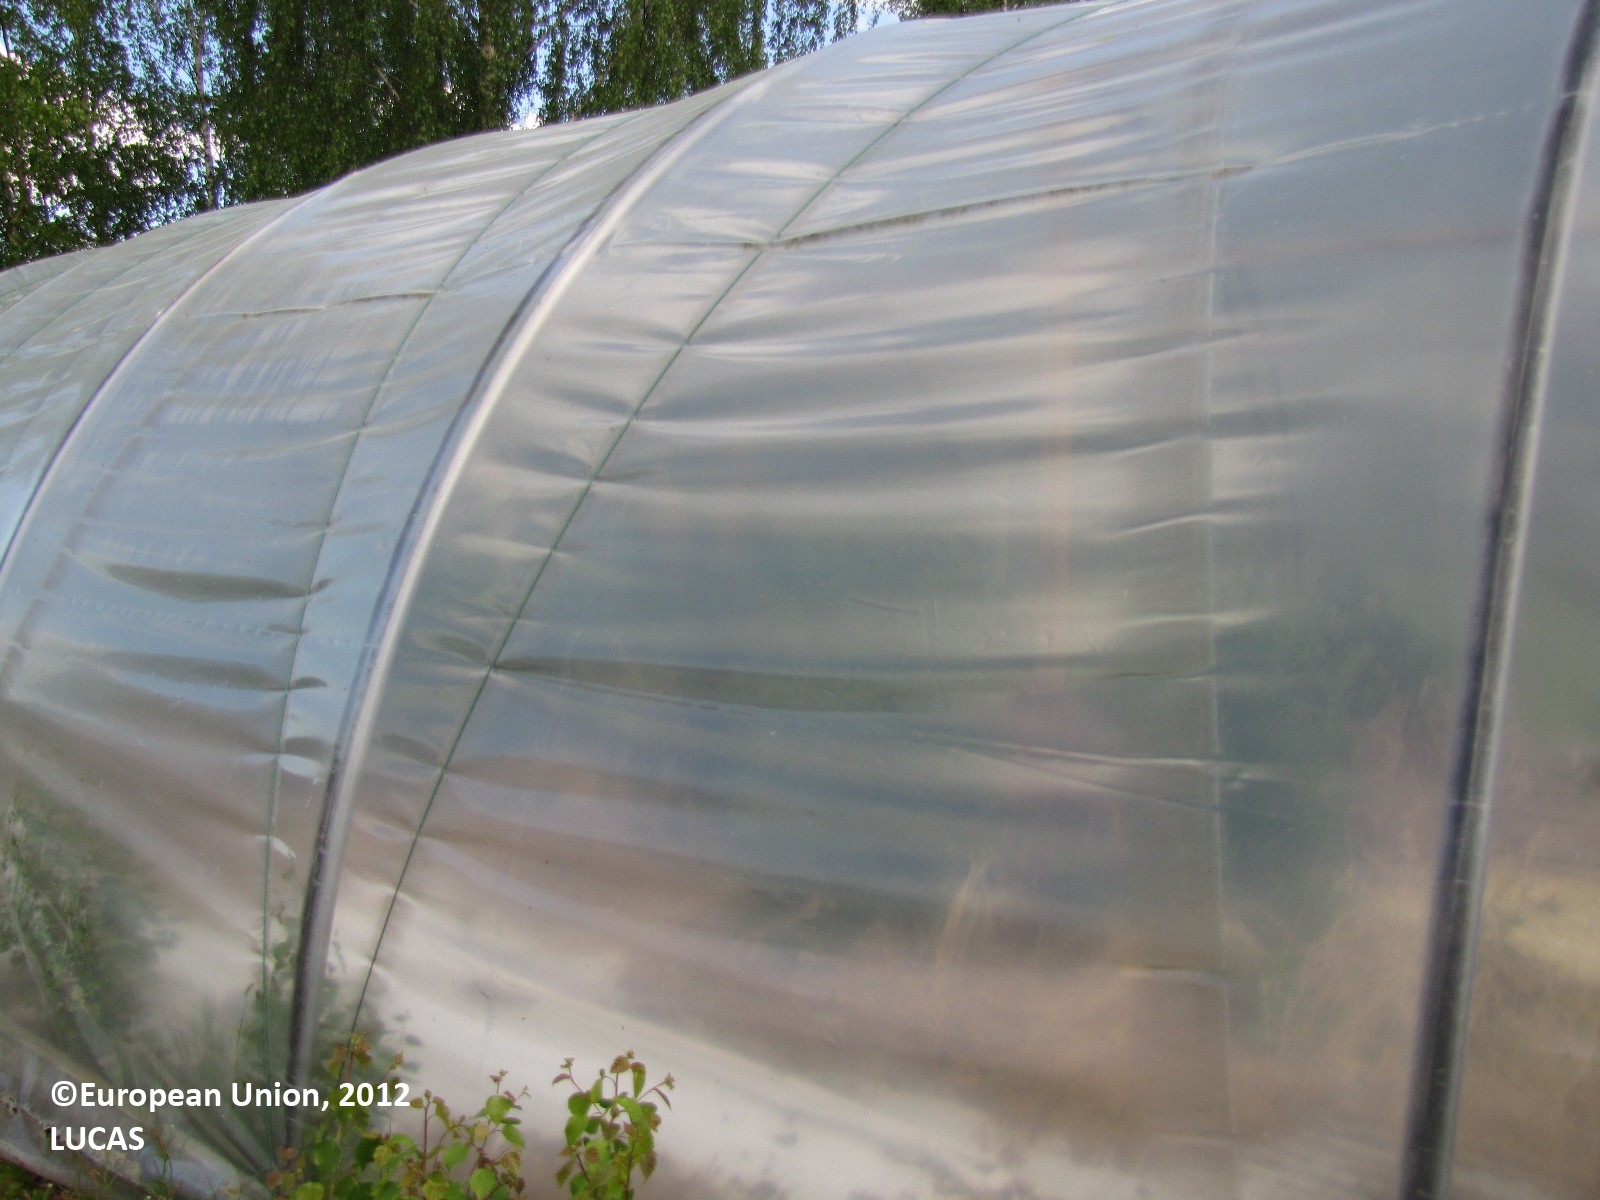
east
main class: Artificial land
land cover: Greenhouses
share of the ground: 25 - 50 %
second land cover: Floriculture and ornamental plants
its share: 25 - 50 %
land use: Agriculture (excluding fallow land and kitchen gardens)
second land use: Fallow land
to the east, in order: Artificial constructions in urban areas; Grass margins; Single bushes/trees; Grassland without tree/shrub cover; Broadleaved woodland; Shrubland without tree cover; Ditches and canals; Barley; Ditches and canals; Broadleaved woodland; Inland running water; Broadleaved woodland; Arable land (only in case pi)
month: June
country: FI
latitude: 61.2834
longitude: 22.9263
